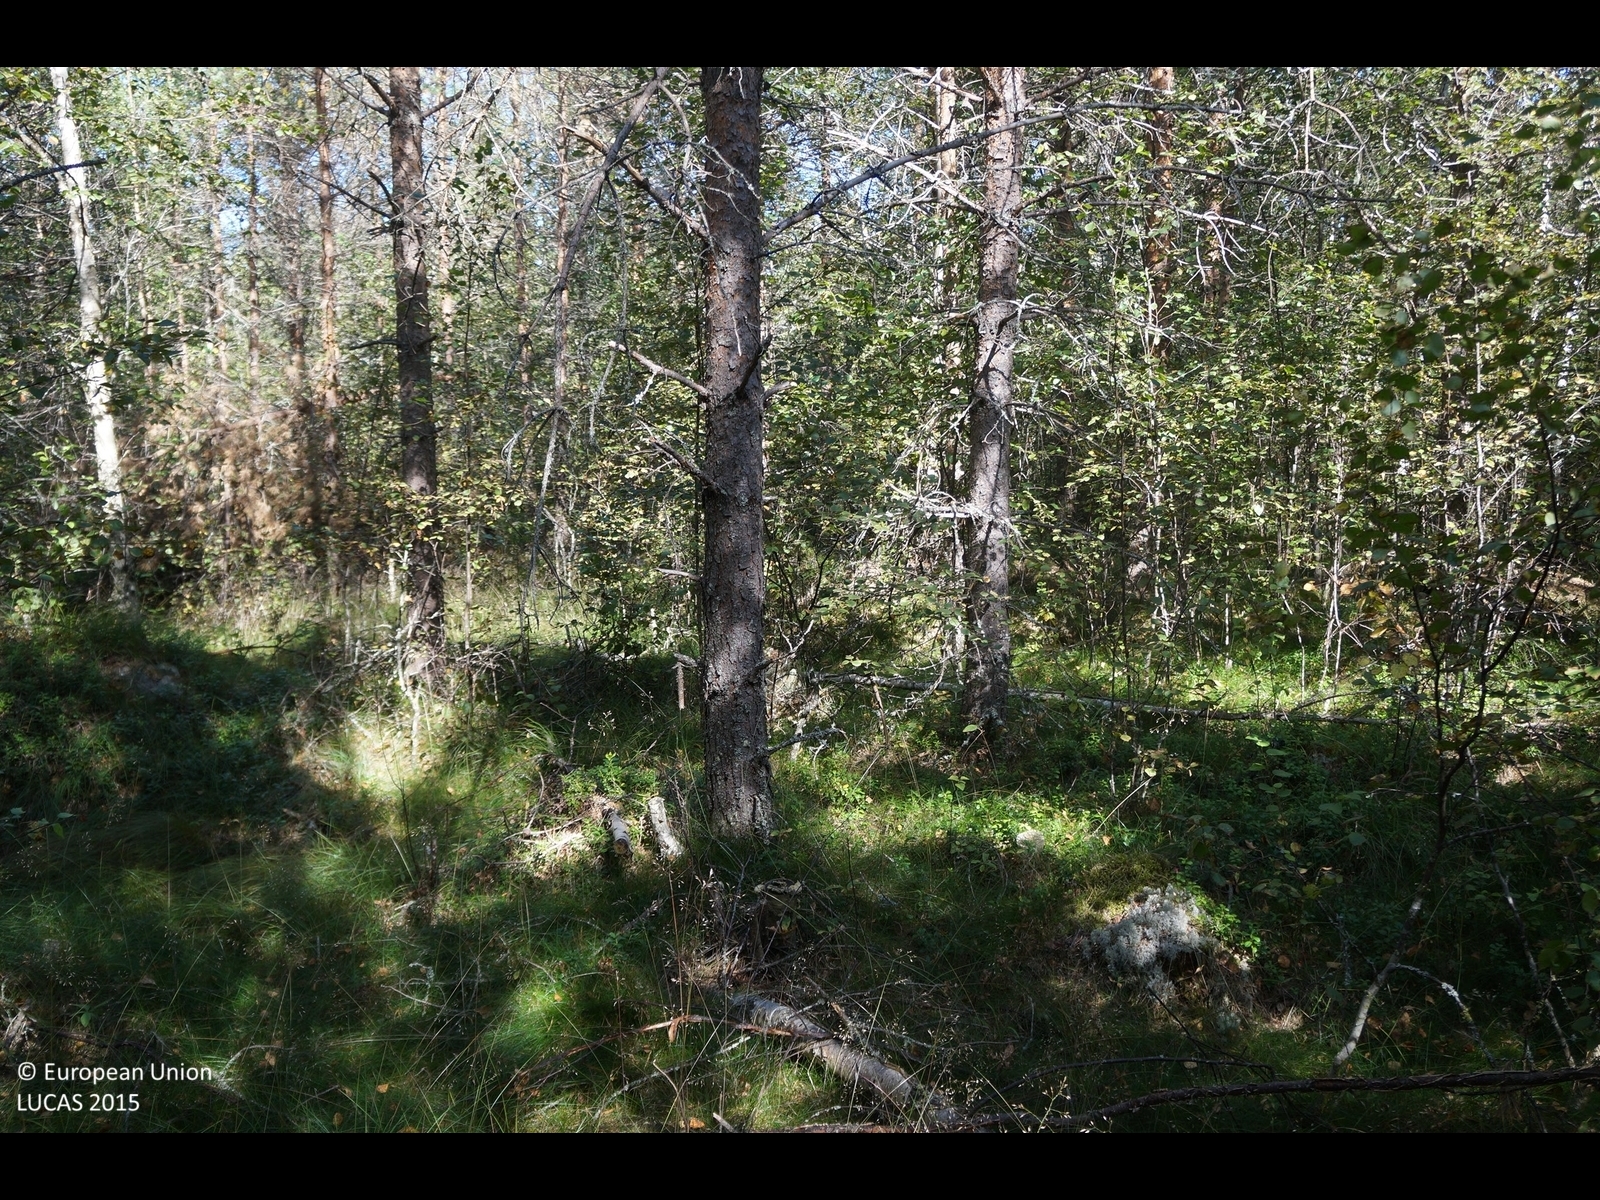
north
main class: Woodland
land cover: Pine dominated mixed woodland
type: boreal forest
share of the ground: 50 - 75 %
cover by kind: coniferous forest trees 50 %, broadleaved forest trees 20 %, herbaceous plants 15 %, shrubs 10 %, lichens and mosses 5 %
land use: Forestry
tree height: > 5 m
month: August
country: FI
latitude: 63.9640
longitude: 23.7217
